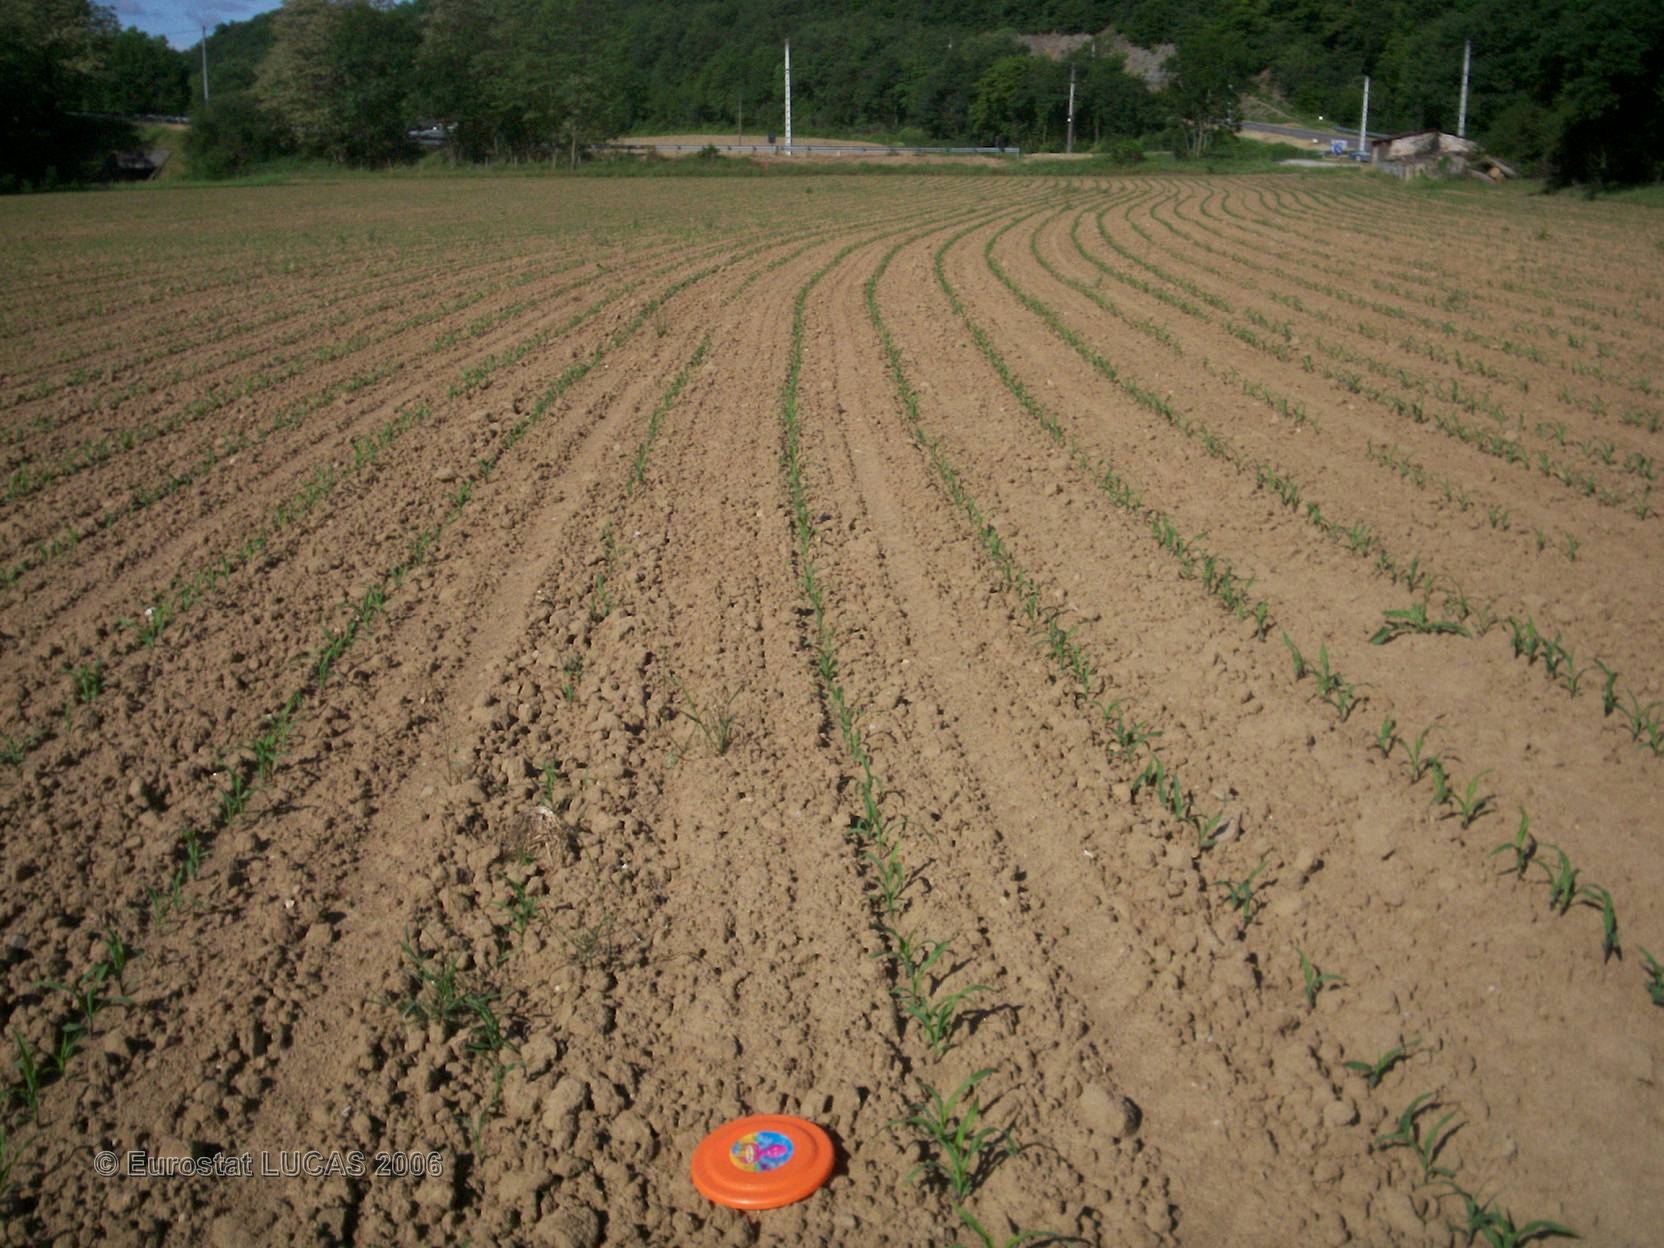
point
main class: Cropland
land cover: Maize
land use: Agriculture (excluding fallow land and kitchen gardens)
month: May
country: FR
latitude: 45.6090
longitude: 4.7595
